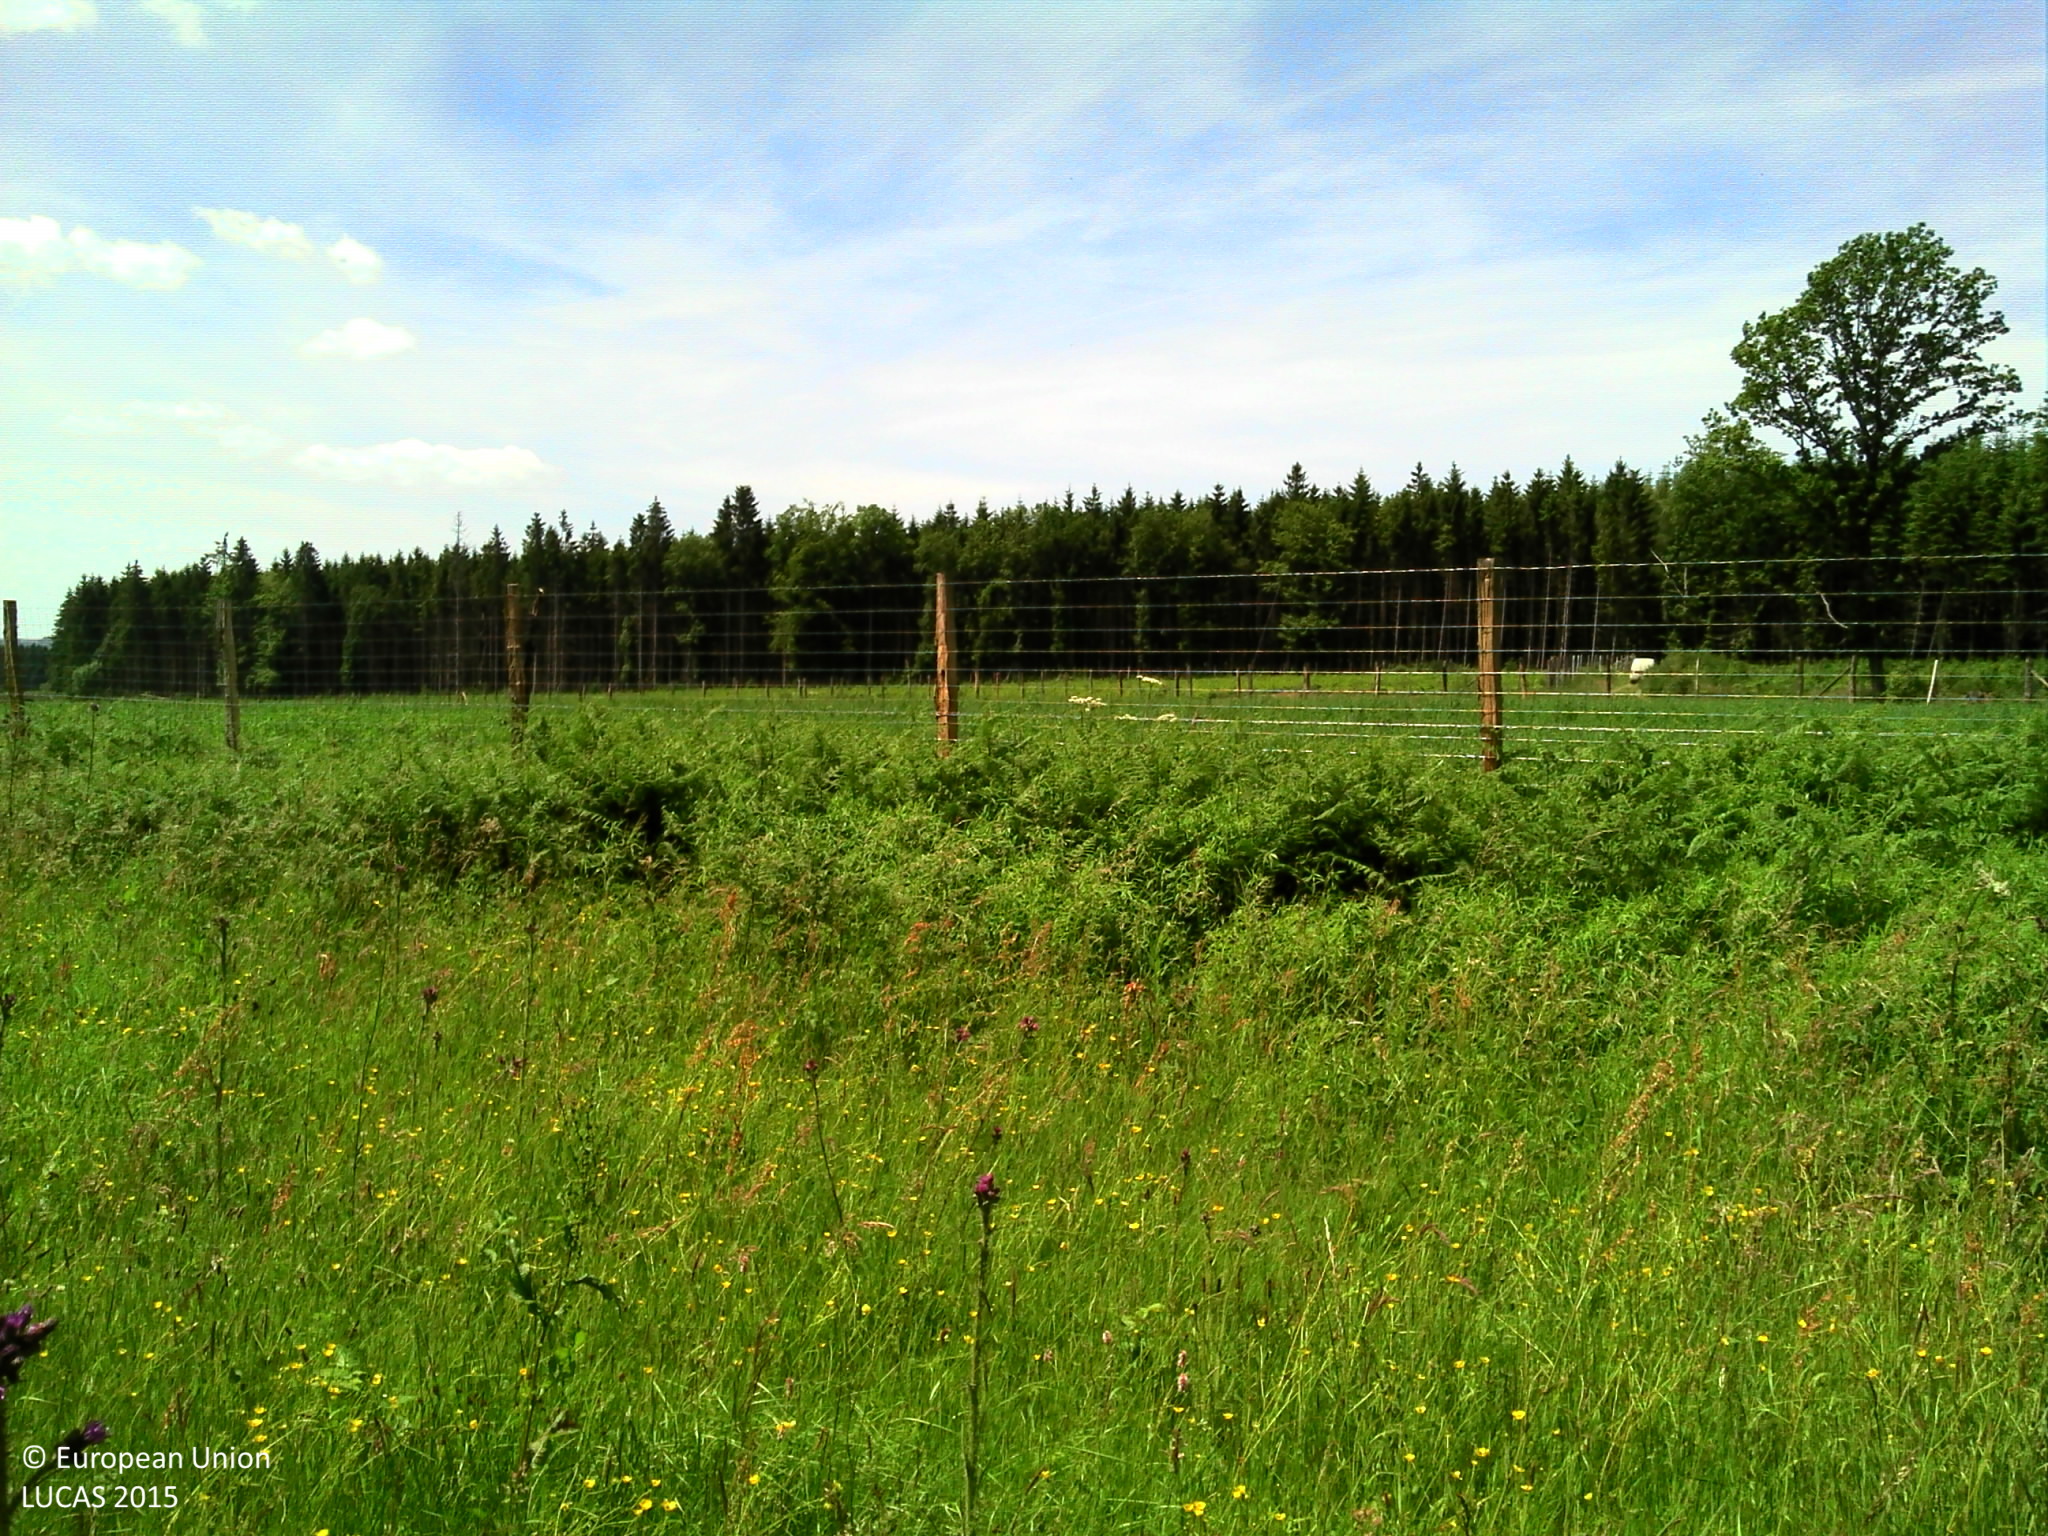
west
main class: Grassland
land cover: Spontaneously vegetated surfaces
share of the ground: > 75 %
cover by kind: herbaceous plants 100 %
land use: Forestry
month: June
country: BE
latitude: 49.9960
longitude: 5.2688
